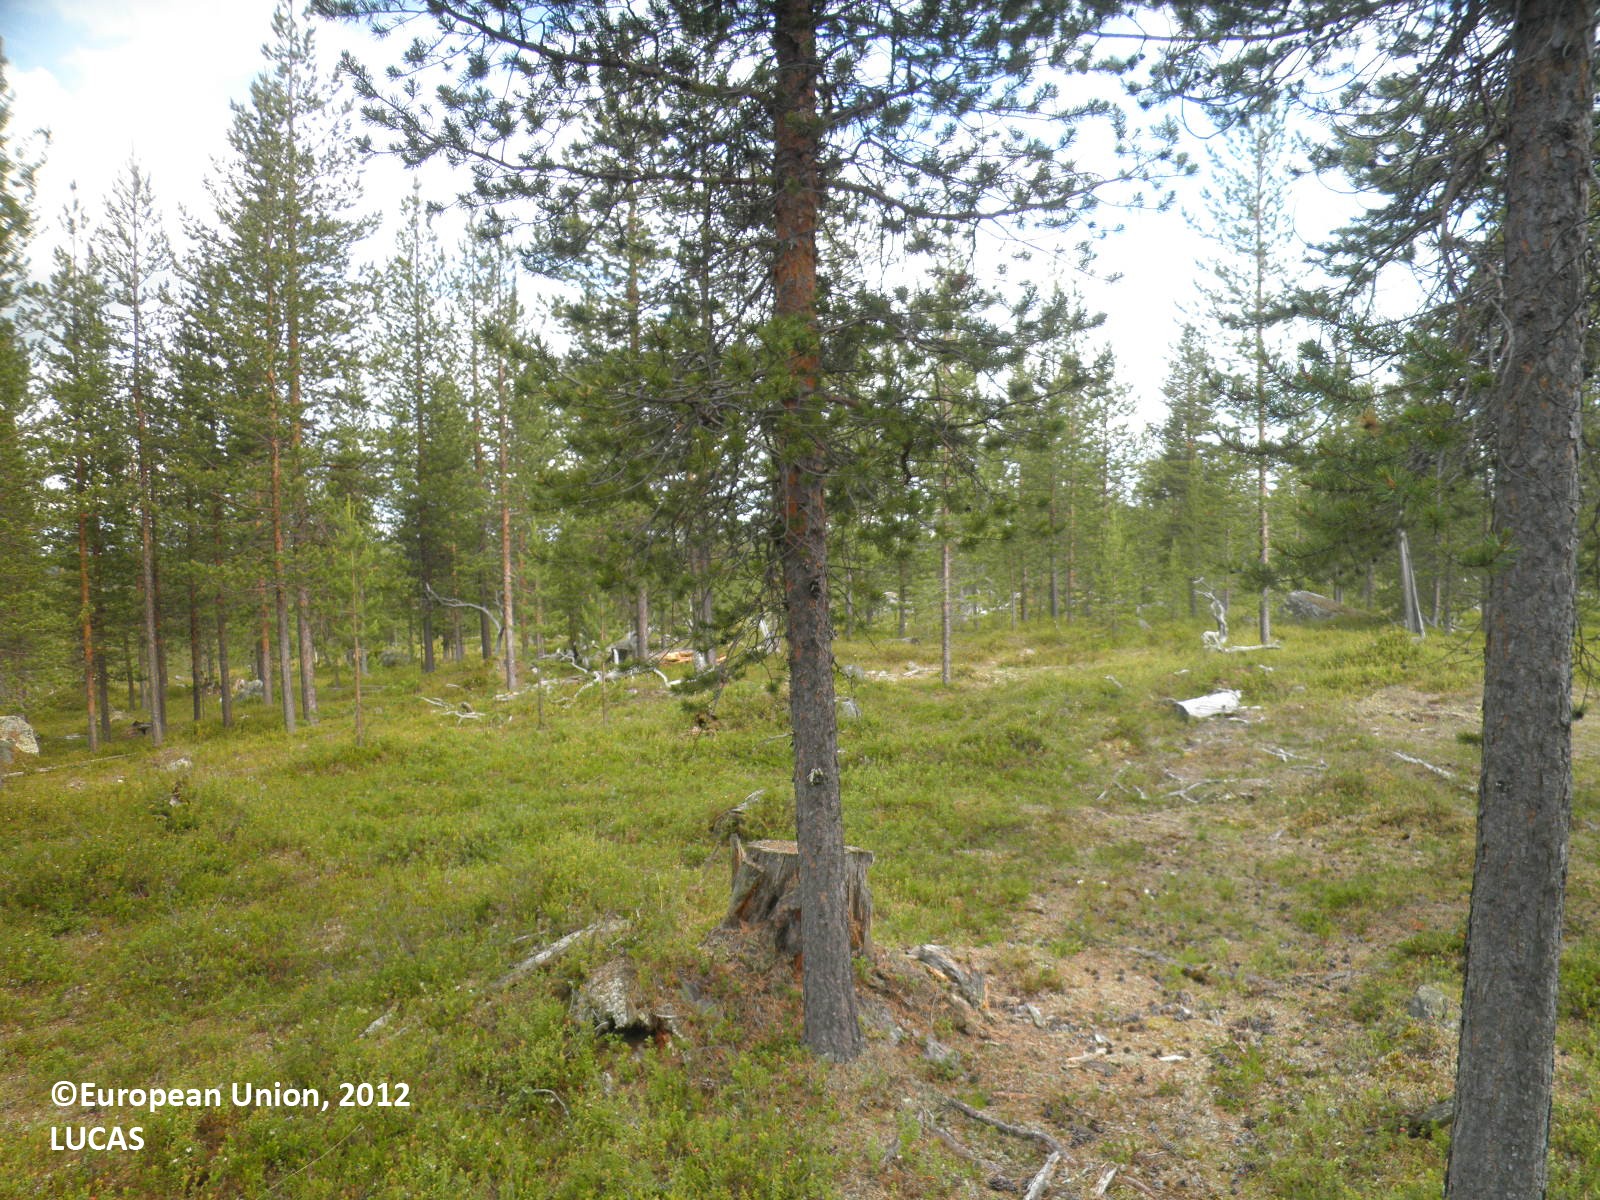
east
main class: Woodland
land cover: Pine dominated coniferous woodland
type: boreal forest
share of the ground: 25 - 50 %
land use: Forestry
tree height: > 5 m
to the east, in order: Pine dominated coniferous woodland; Shrubland with sparse tree cover; Pine dominated coniferous woodland; Shrubland with sparse tree cover; Pine dominated coniferous woodland
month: July
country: FI
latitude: 68.6455
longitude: 27.8289
